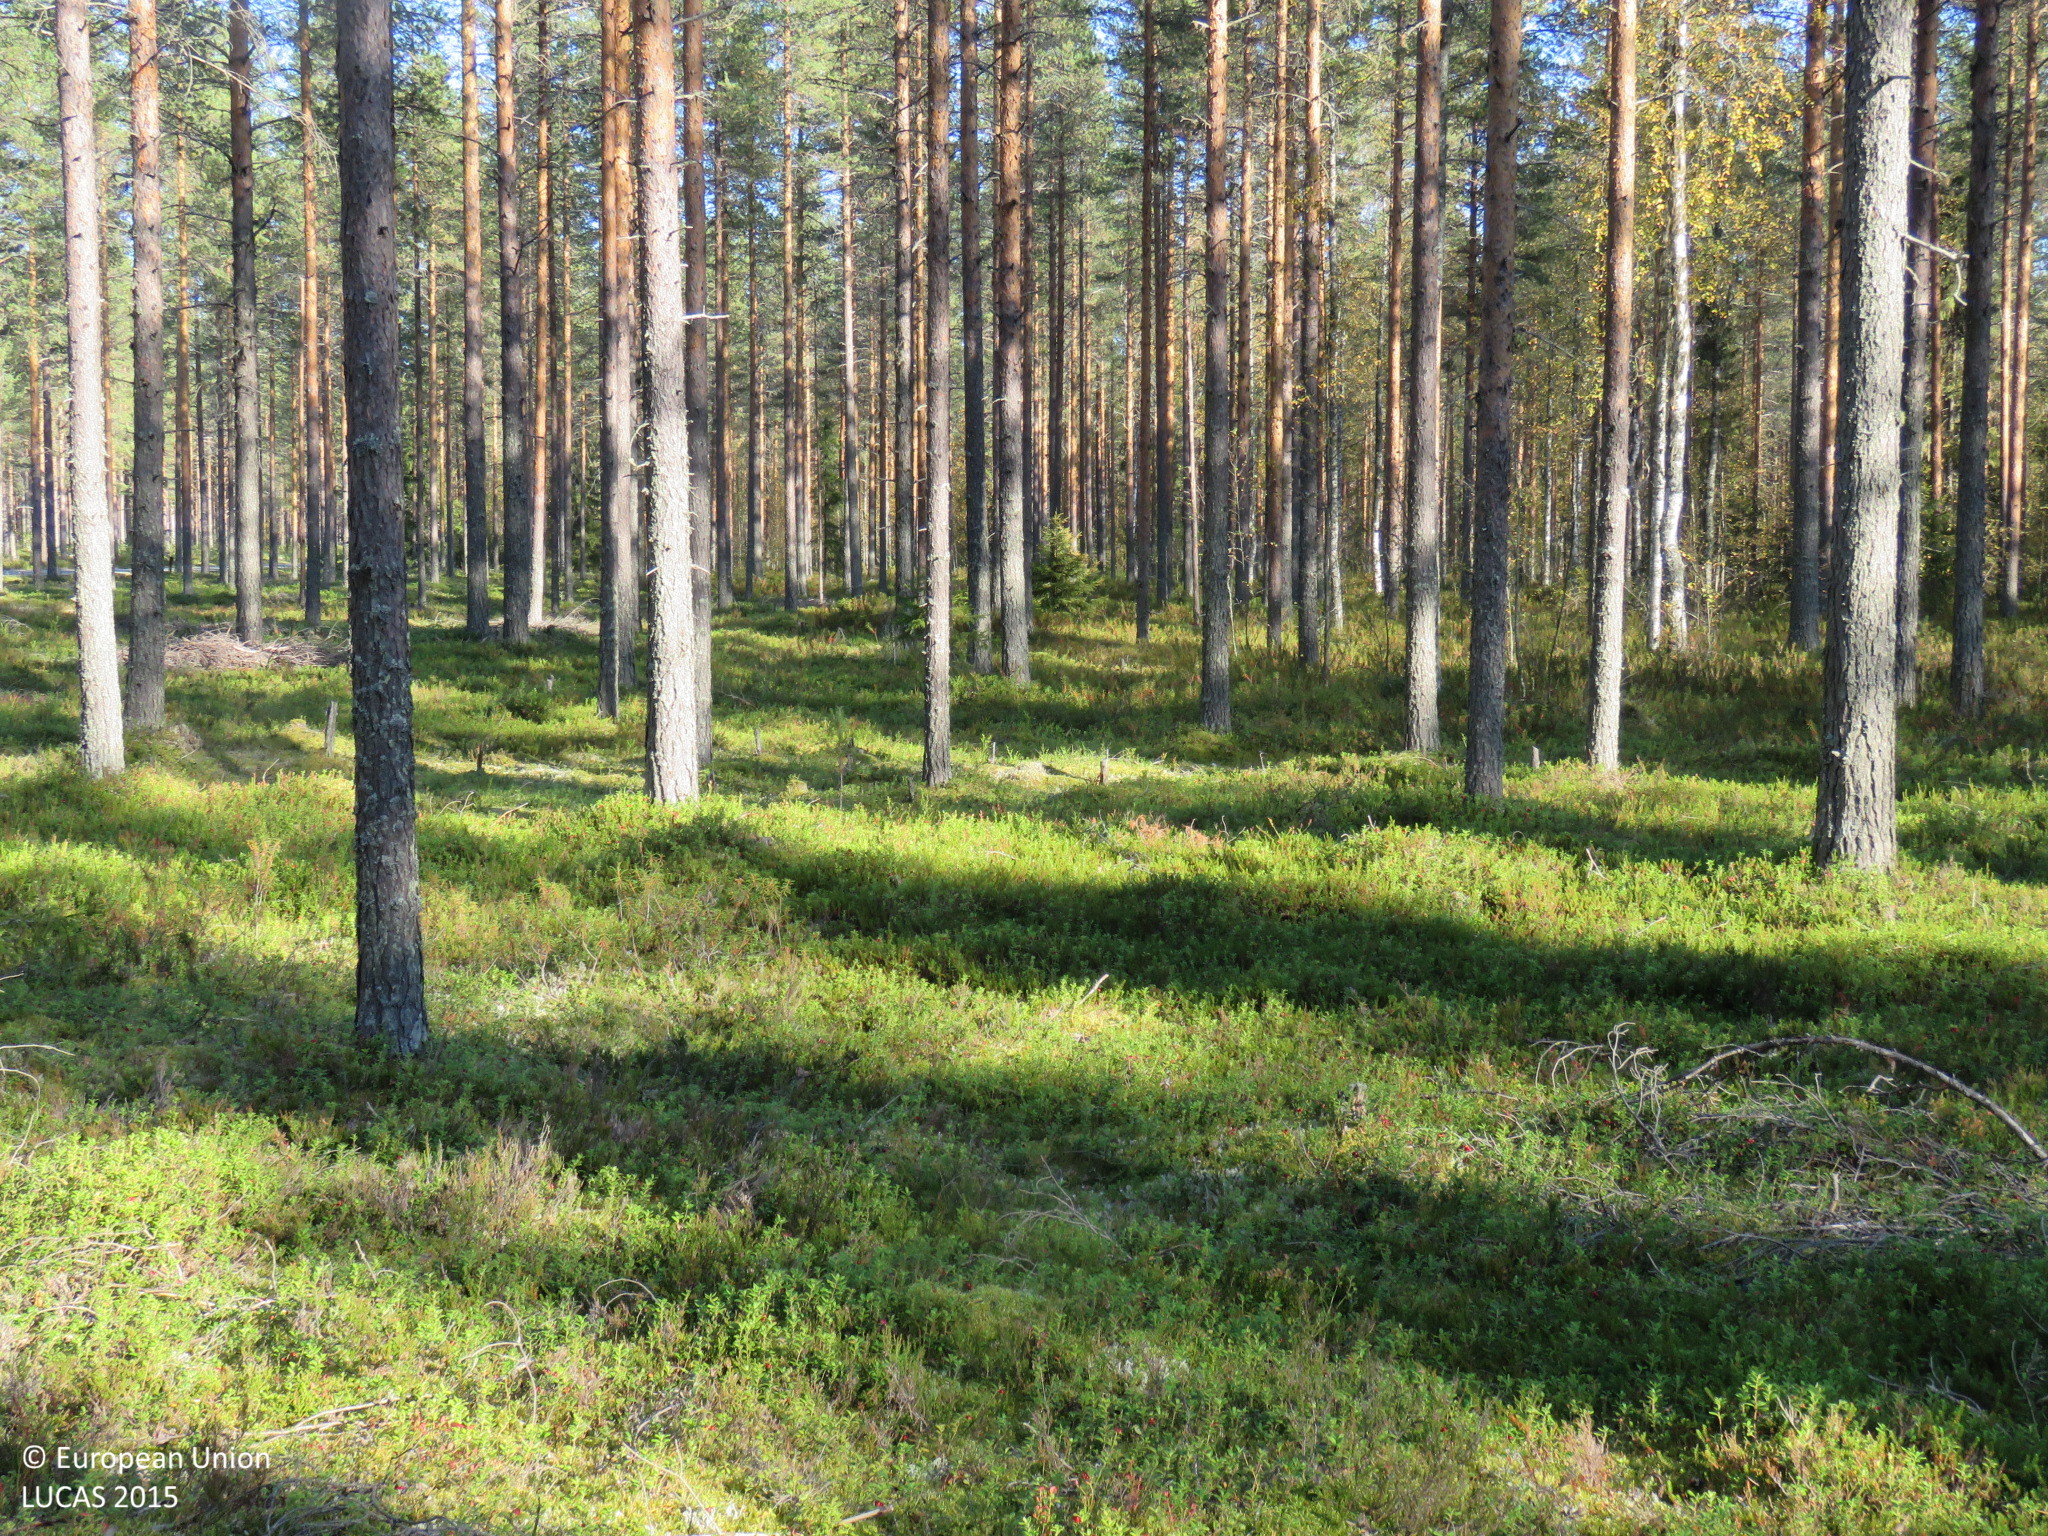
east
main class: Woodland
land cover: Pine dominated coniferous woodland
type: boreal forest
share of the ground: > 75 %
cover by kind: coniferous forest trees 75 %, shrubs 15 %, lichens and mosses 10 %
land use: Forestry
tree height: > 5 m
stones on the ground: < 10 %
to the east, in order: Pine dominated coniferous woodland; Other mixed woodland; Pine dominated coniferous woodland; Grass margins; Paved roads, cycling and walking lanes
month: September
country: FI
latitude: 64.9648
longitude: 26.3922
